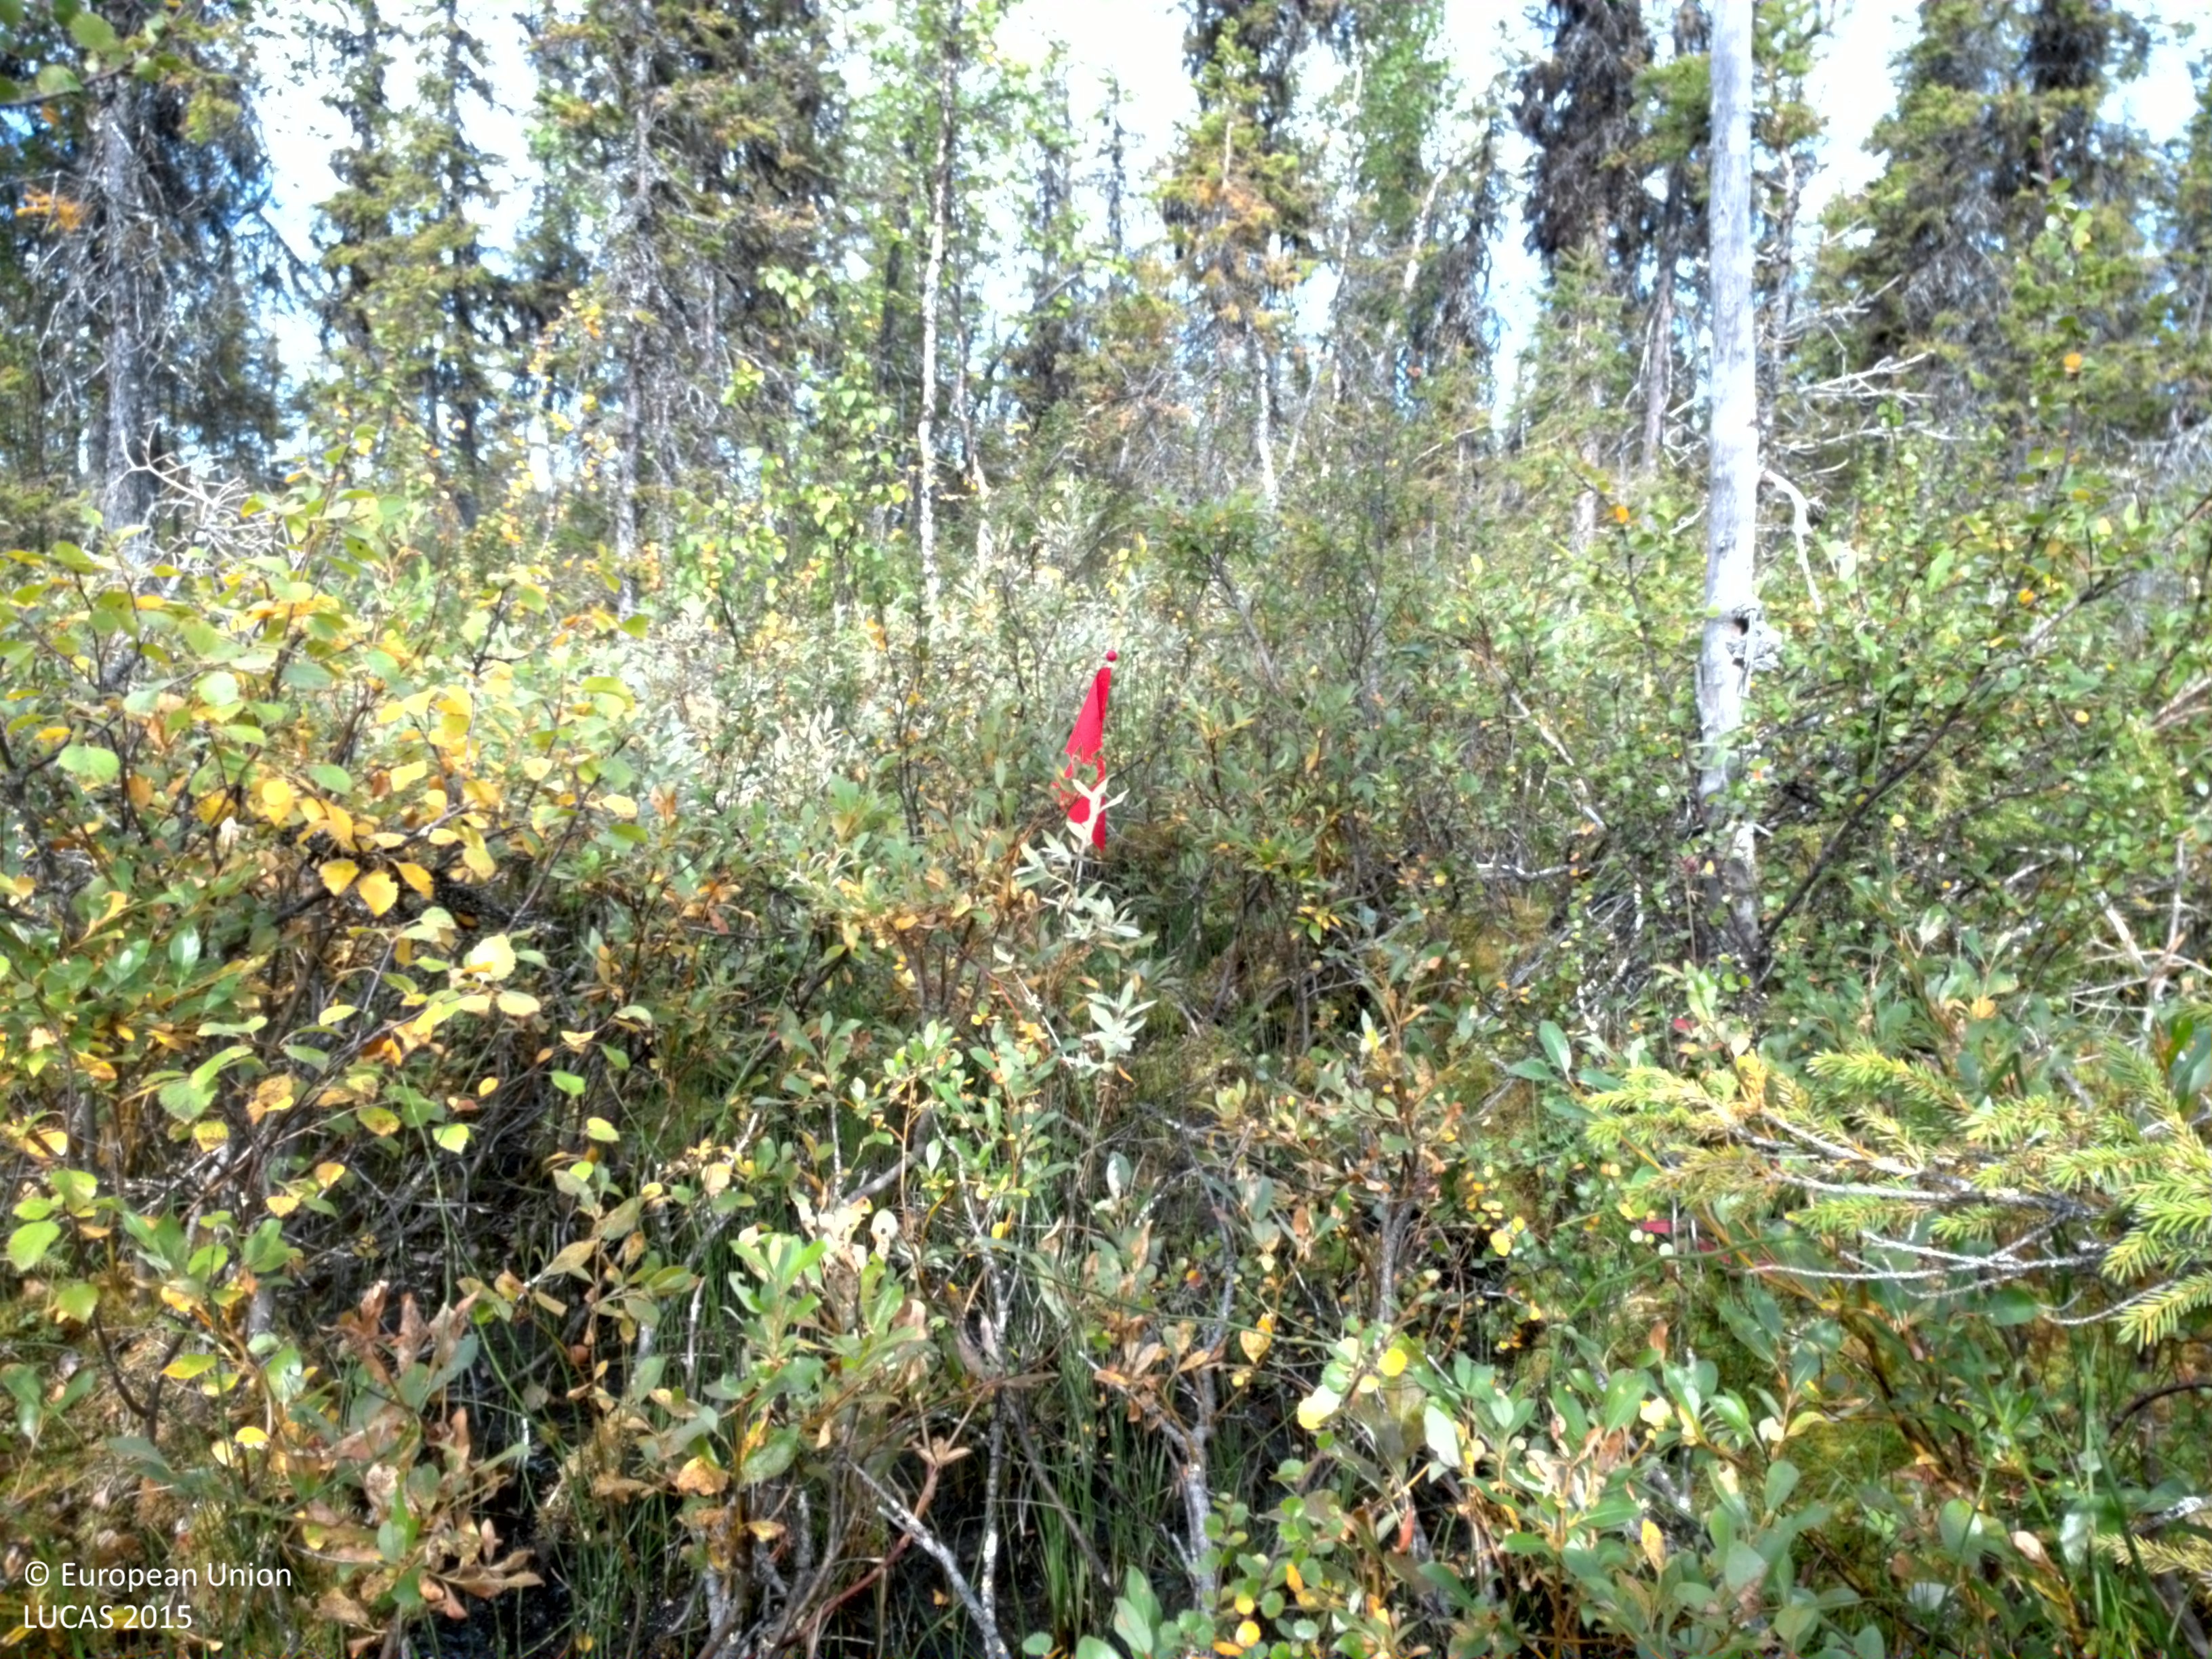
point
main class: Woodland
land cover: Spruce dominated coniferous woodland
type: boreal forest
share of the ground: 25 - 50 %
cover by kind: shrubs 60 %, coniferous forest trees 30 %, herbaceous plants 5 %, lichens and mosses 5 %
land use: Forestry
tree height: > 5 m
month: August
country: SE
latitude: 66.9012
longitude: 19.1987
